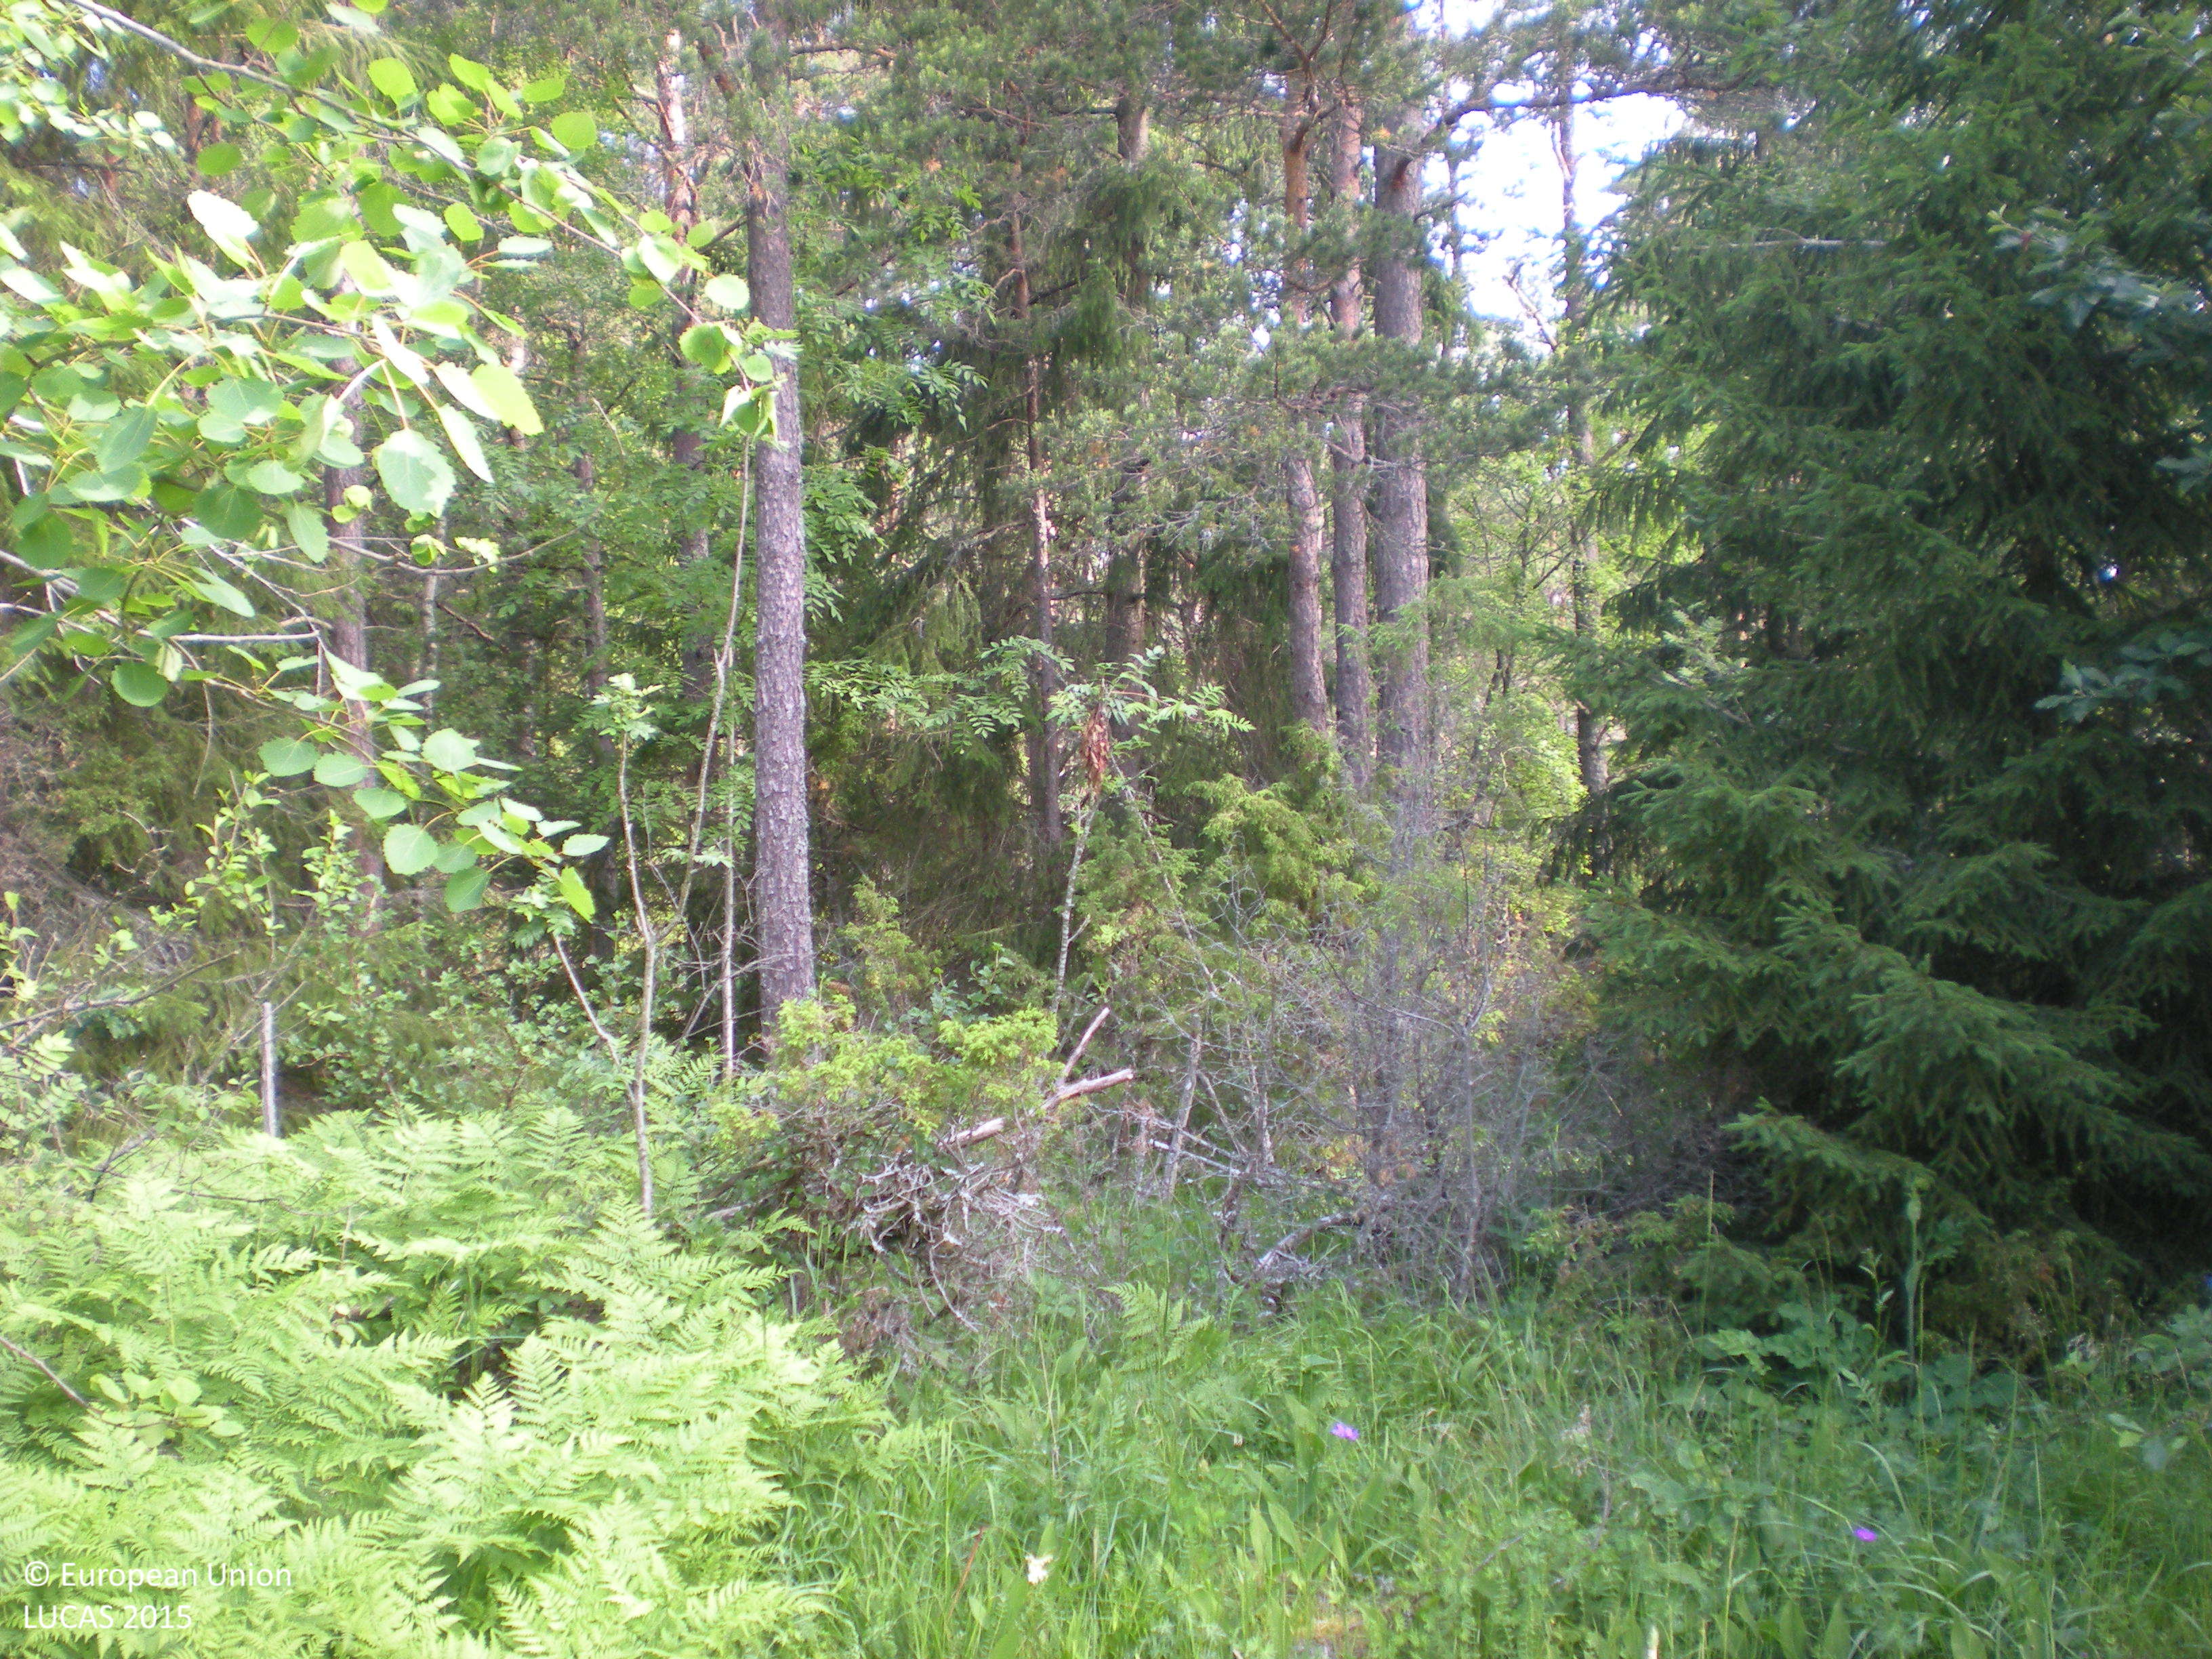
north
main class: Grassland
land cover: Grassland without tree/shrub cover
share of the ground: > 75 %
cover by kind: herbaceous plants 100 %
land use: Agriculture (excluding fallow land and kitchen gardens)
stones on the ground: 10 - 25 %
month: July
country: SE
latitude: 60.5015
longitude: 17.9121
